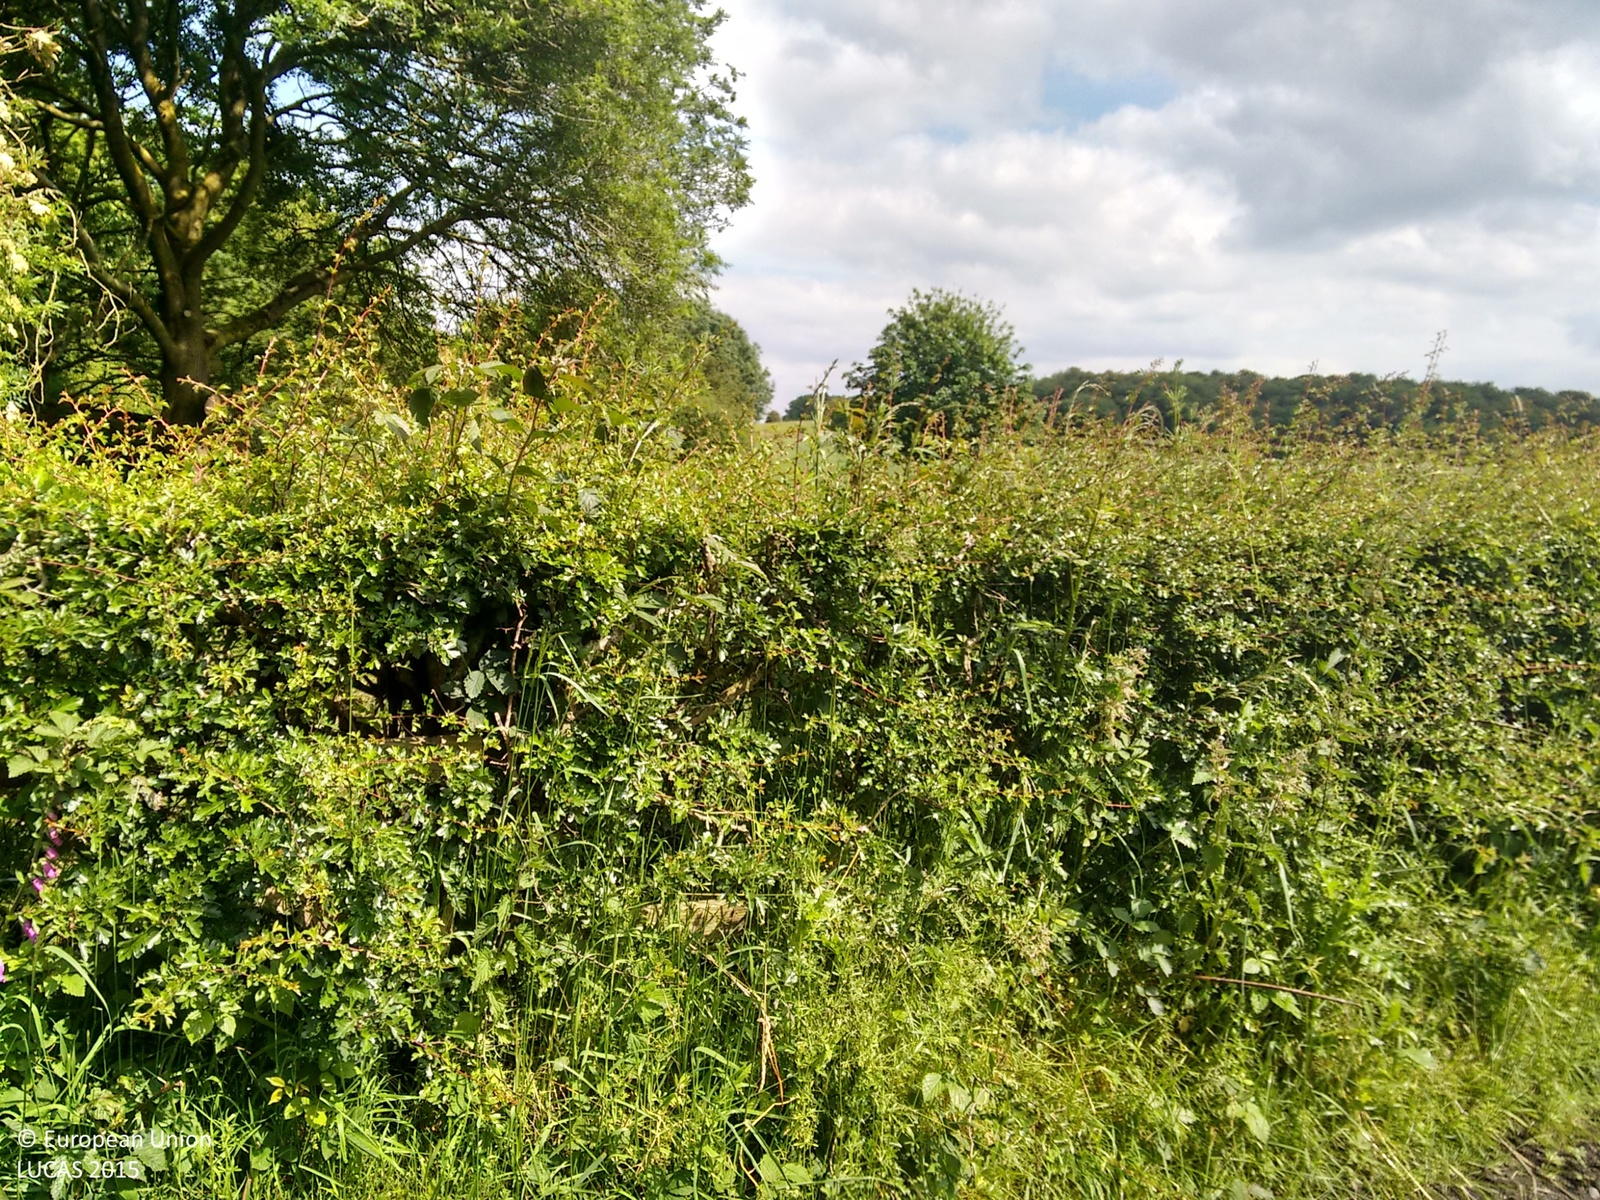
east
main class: Grassland
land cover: Grassland without tree/shrub cover
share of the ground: > 75 %
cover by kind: herbaceous plants 100 %
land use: Agriculture (excluding fallow land and kitchen gardens)
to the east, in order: Grassland without tree/shrub cover; Managed hedges; Tracks; Managed hedges; Grassland without tree/shrub cover; Fences; Grassland with sparse tree/shrub cover; Paved roads, cycling and walking lanes
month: June
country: GB
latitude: 53.5533
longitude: -2.4879
